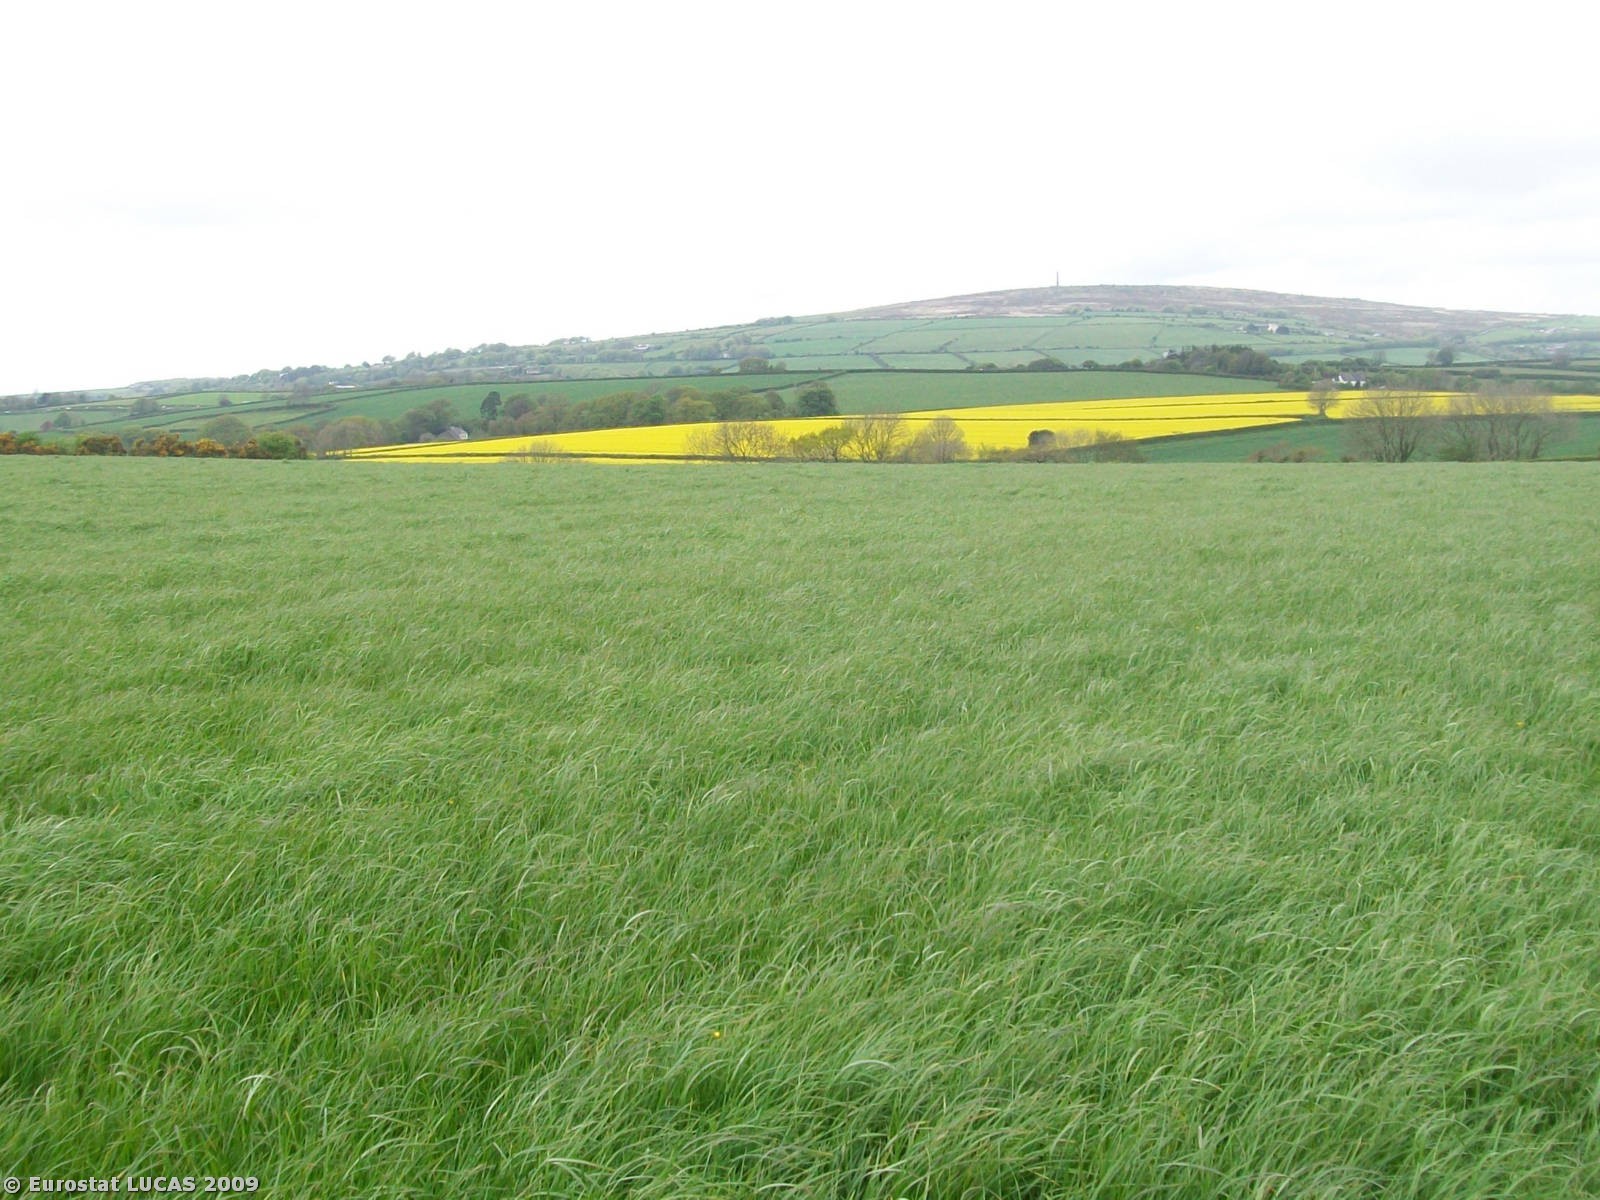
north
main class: Grassland
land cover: Grassland without tree/shrub cover
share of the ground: > 75 %
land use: Agriculture (excluding fallow land and kitchen gardens)
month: May
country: GB
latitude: 50.4835
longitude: -4.2919
